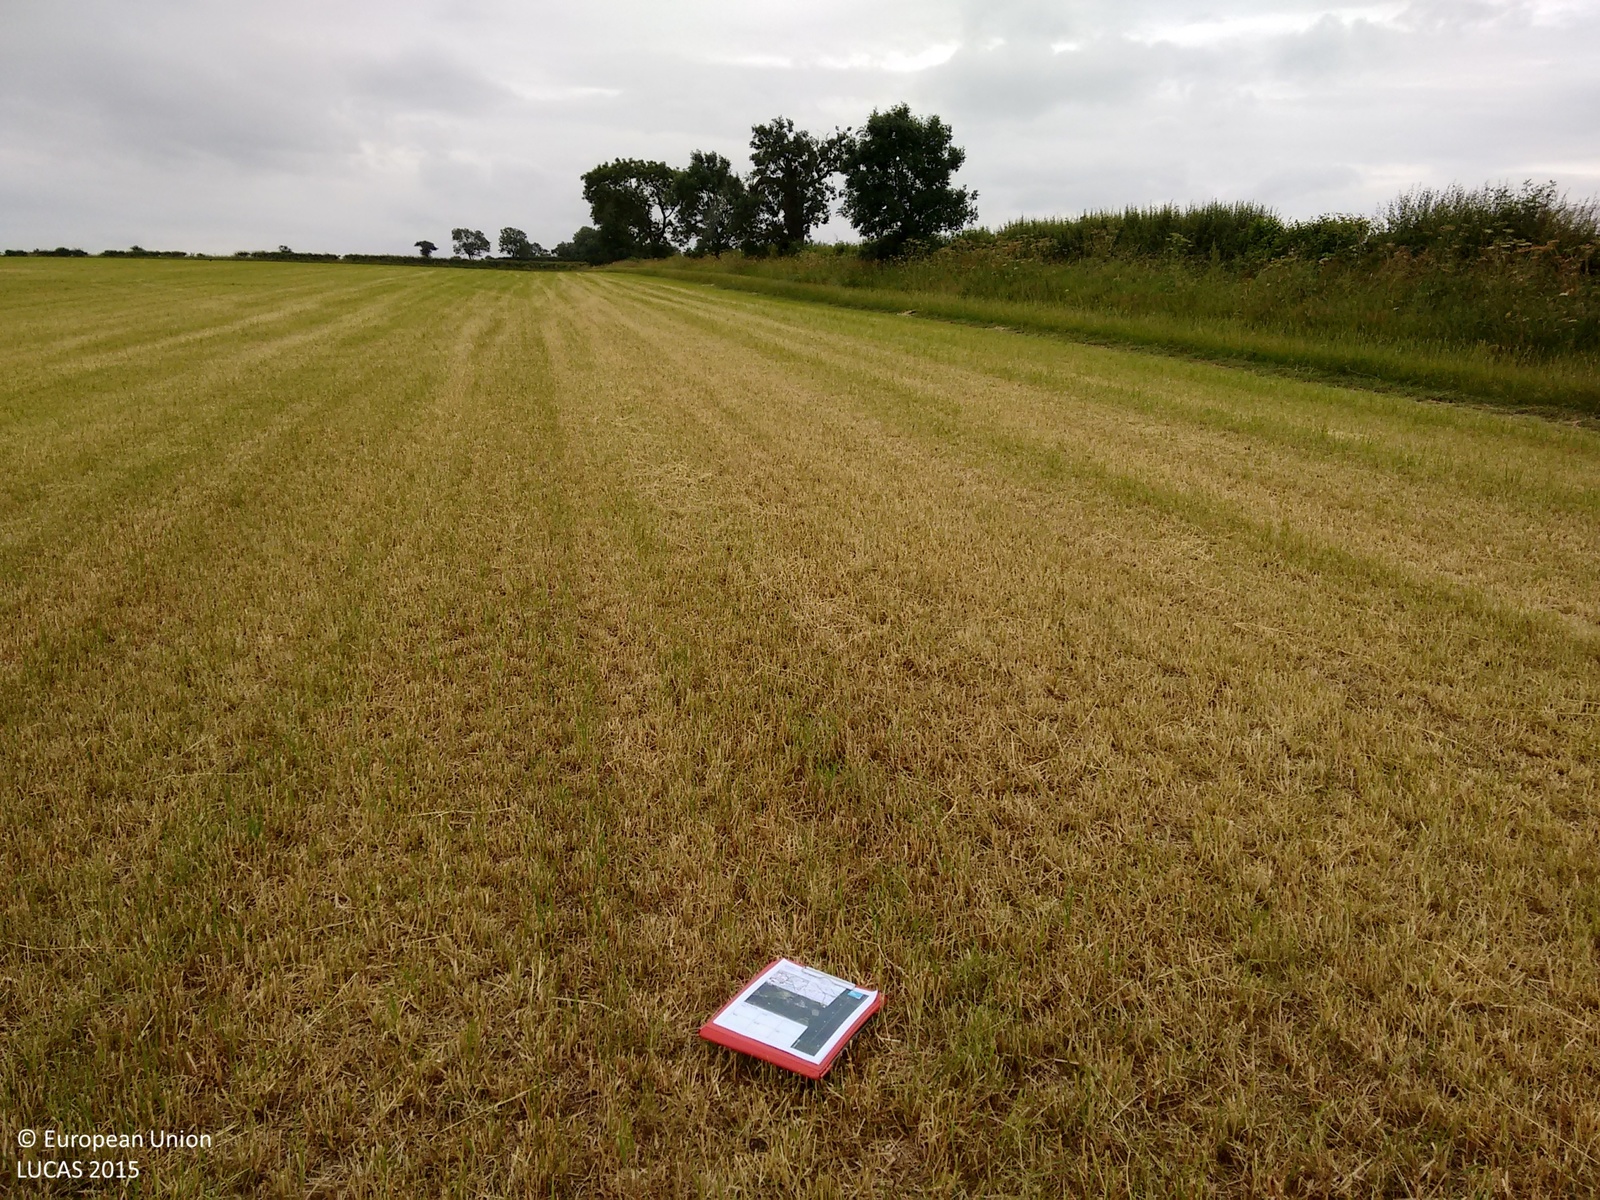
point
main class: Grassland
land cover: Grassland without tree/shrub cover
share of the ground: > 75 %
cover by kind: herbaceous plants 100 %
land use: Agriculture (excluding fallow land and kitchen gardens)
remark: Harvested field
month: July
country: GB
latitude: 52.8255
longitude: -1.0115
